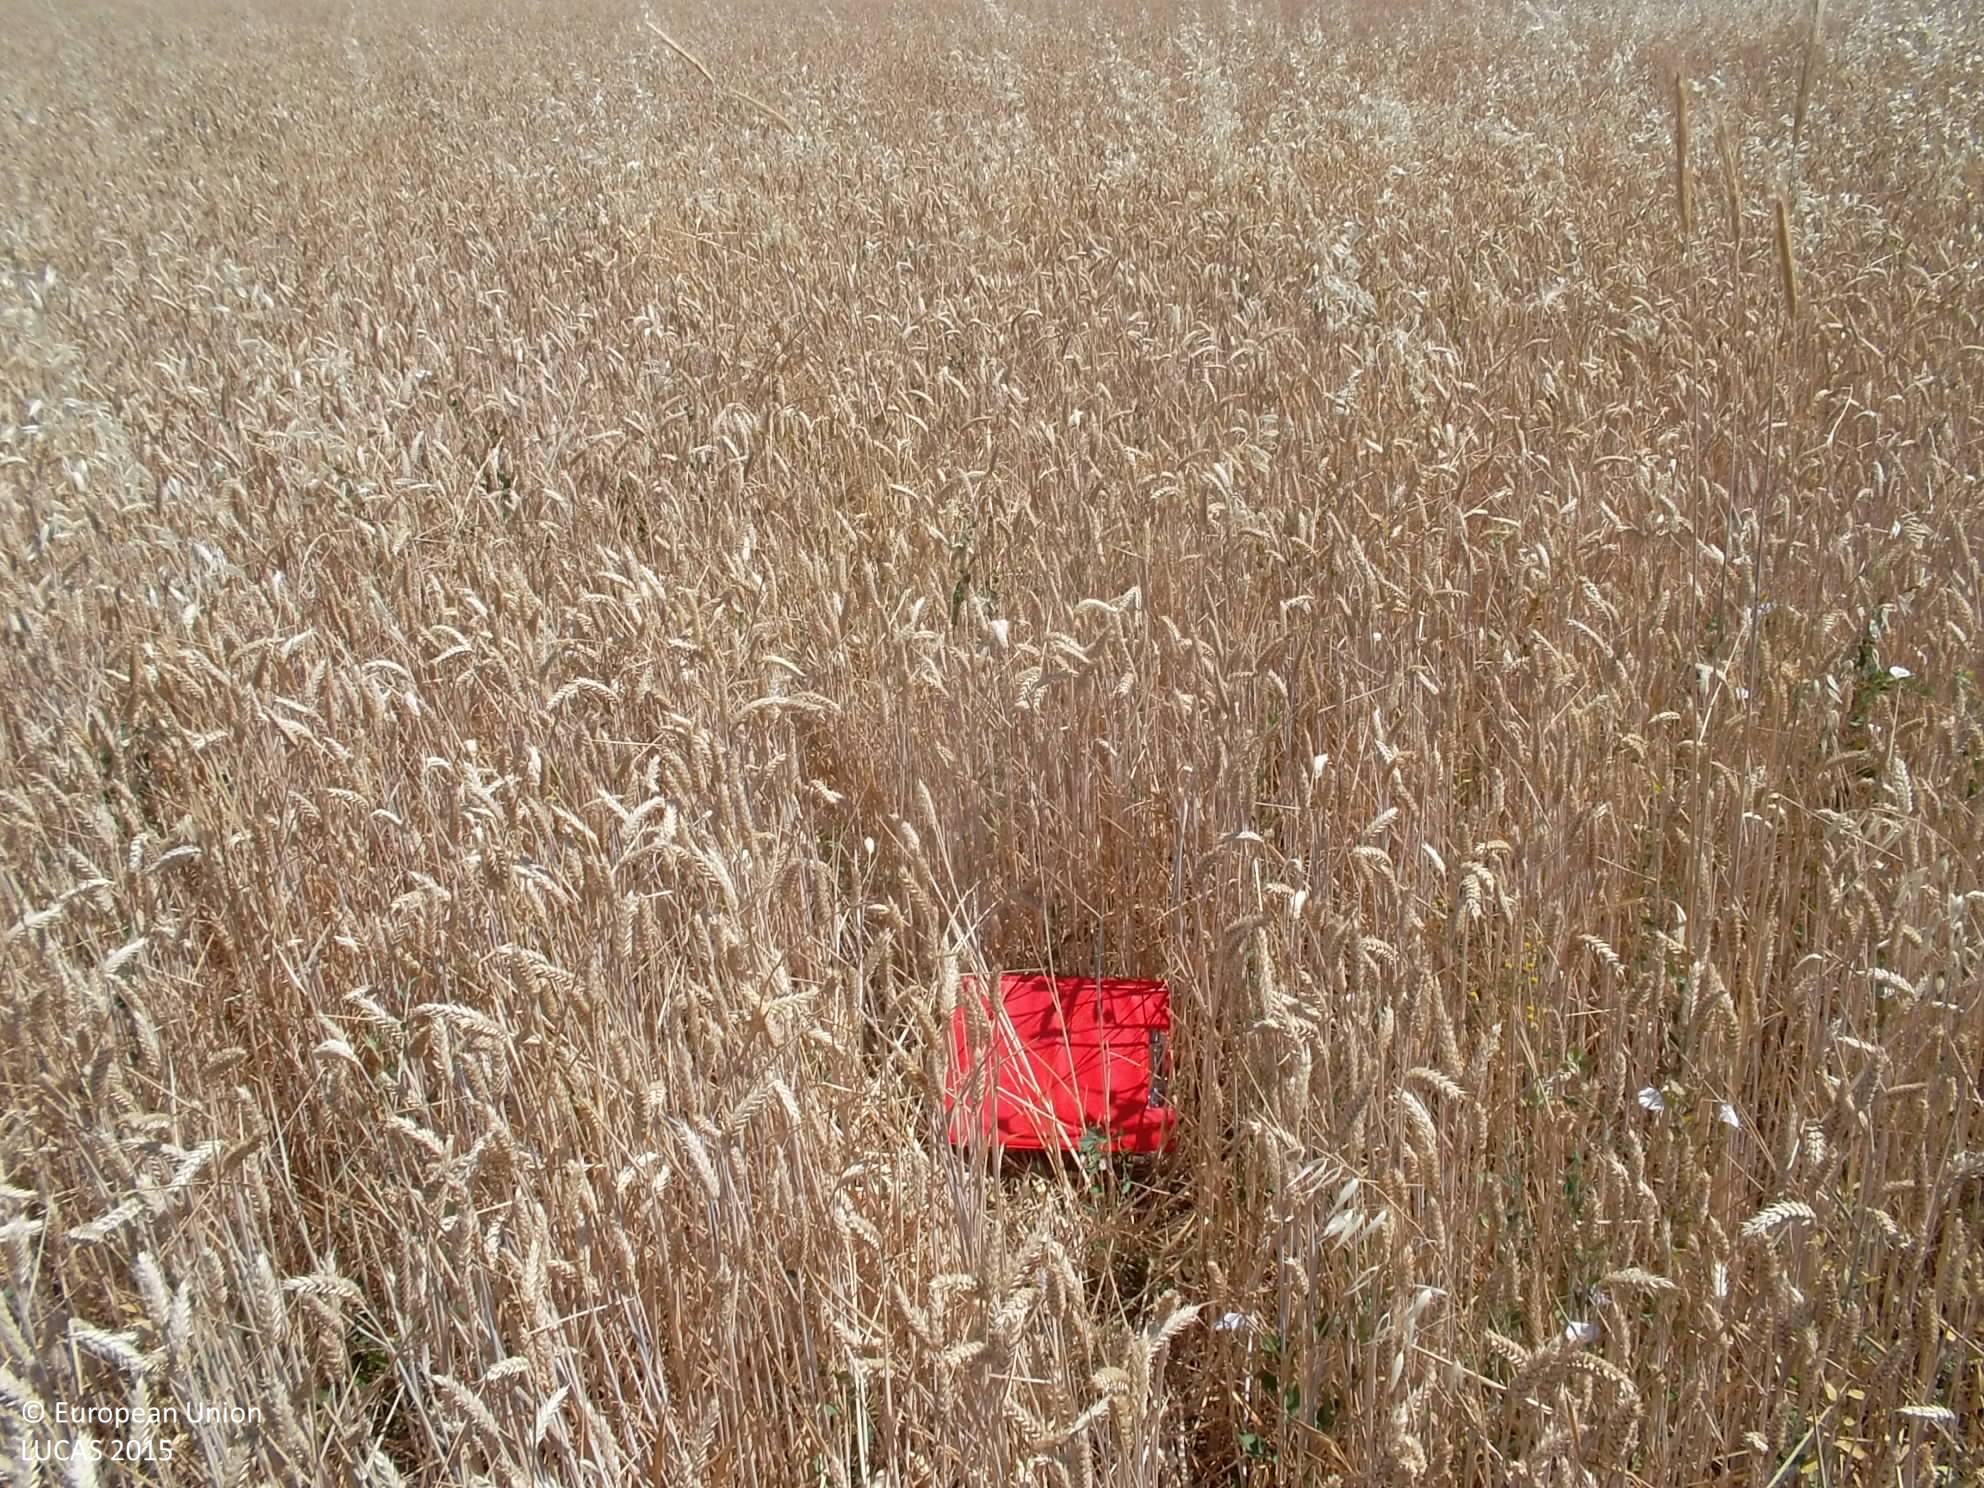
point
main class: Cropland
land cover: Common wheat
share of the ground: > 75 %
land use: Agriculture (excluding fallow land and kitchen gardens)
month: June
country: ES
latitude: 39.0617
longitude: -4.0882
